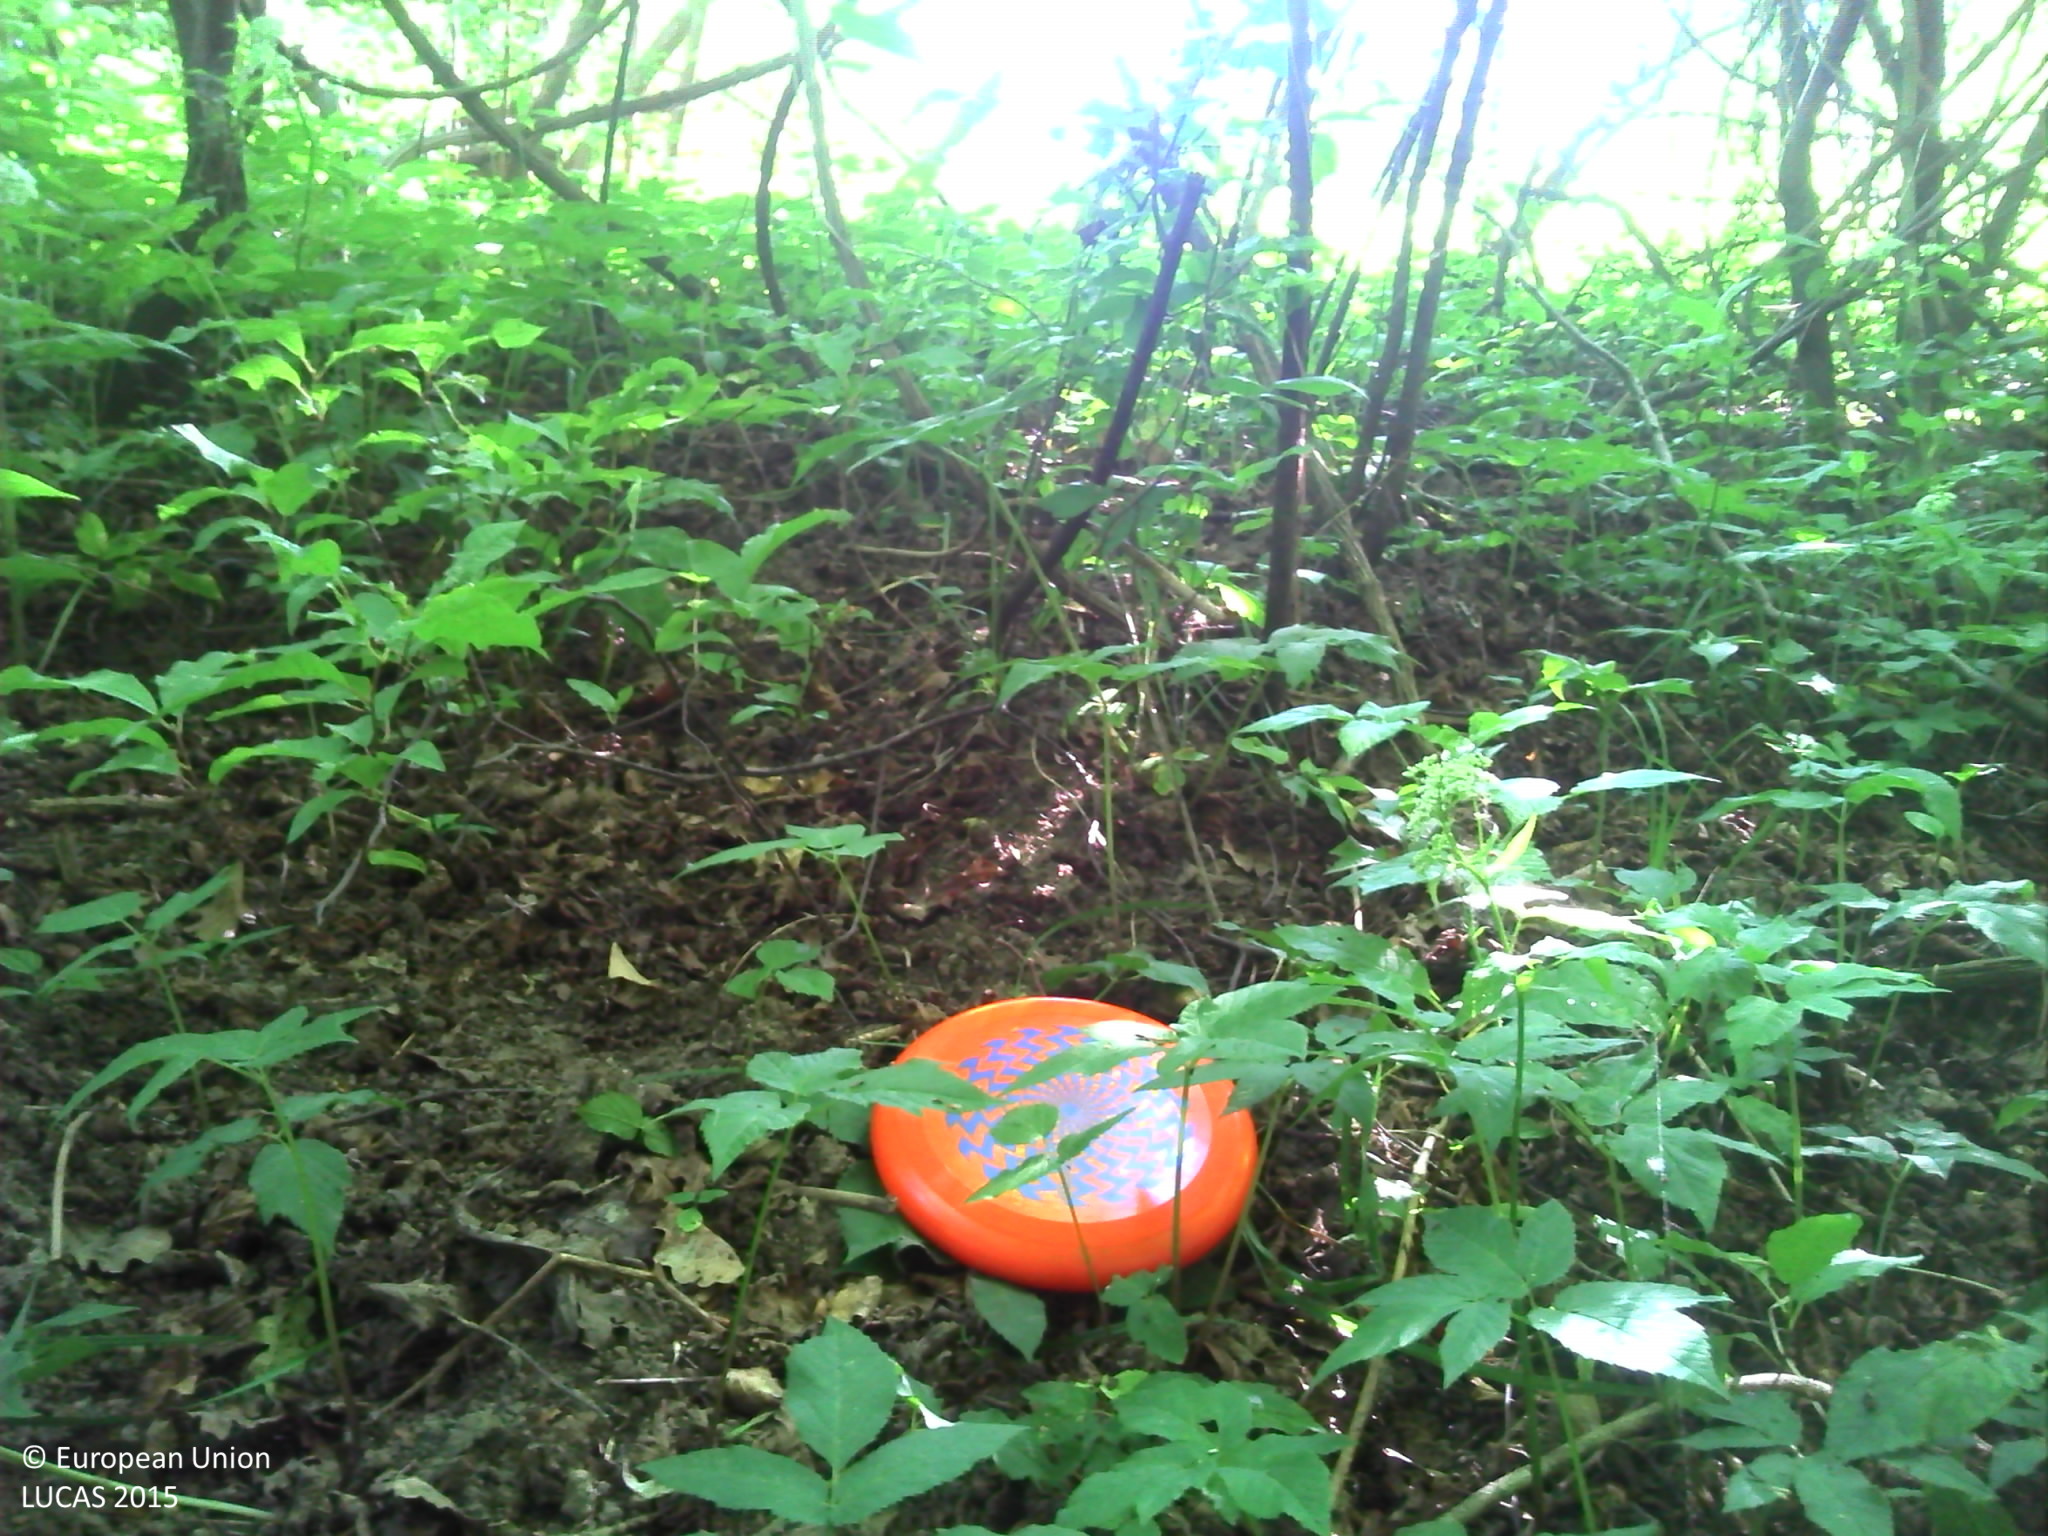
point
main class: Woodland
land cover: Broadleaved woodland
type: mesophytic deciduous forest
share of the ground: > 75 %
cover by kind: broadleaved forest trees 95 %, herbaceous plants 5 %
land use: Forestry
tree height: > 5 m
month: June
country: FR
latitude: 48.3620
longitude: 7.7199
